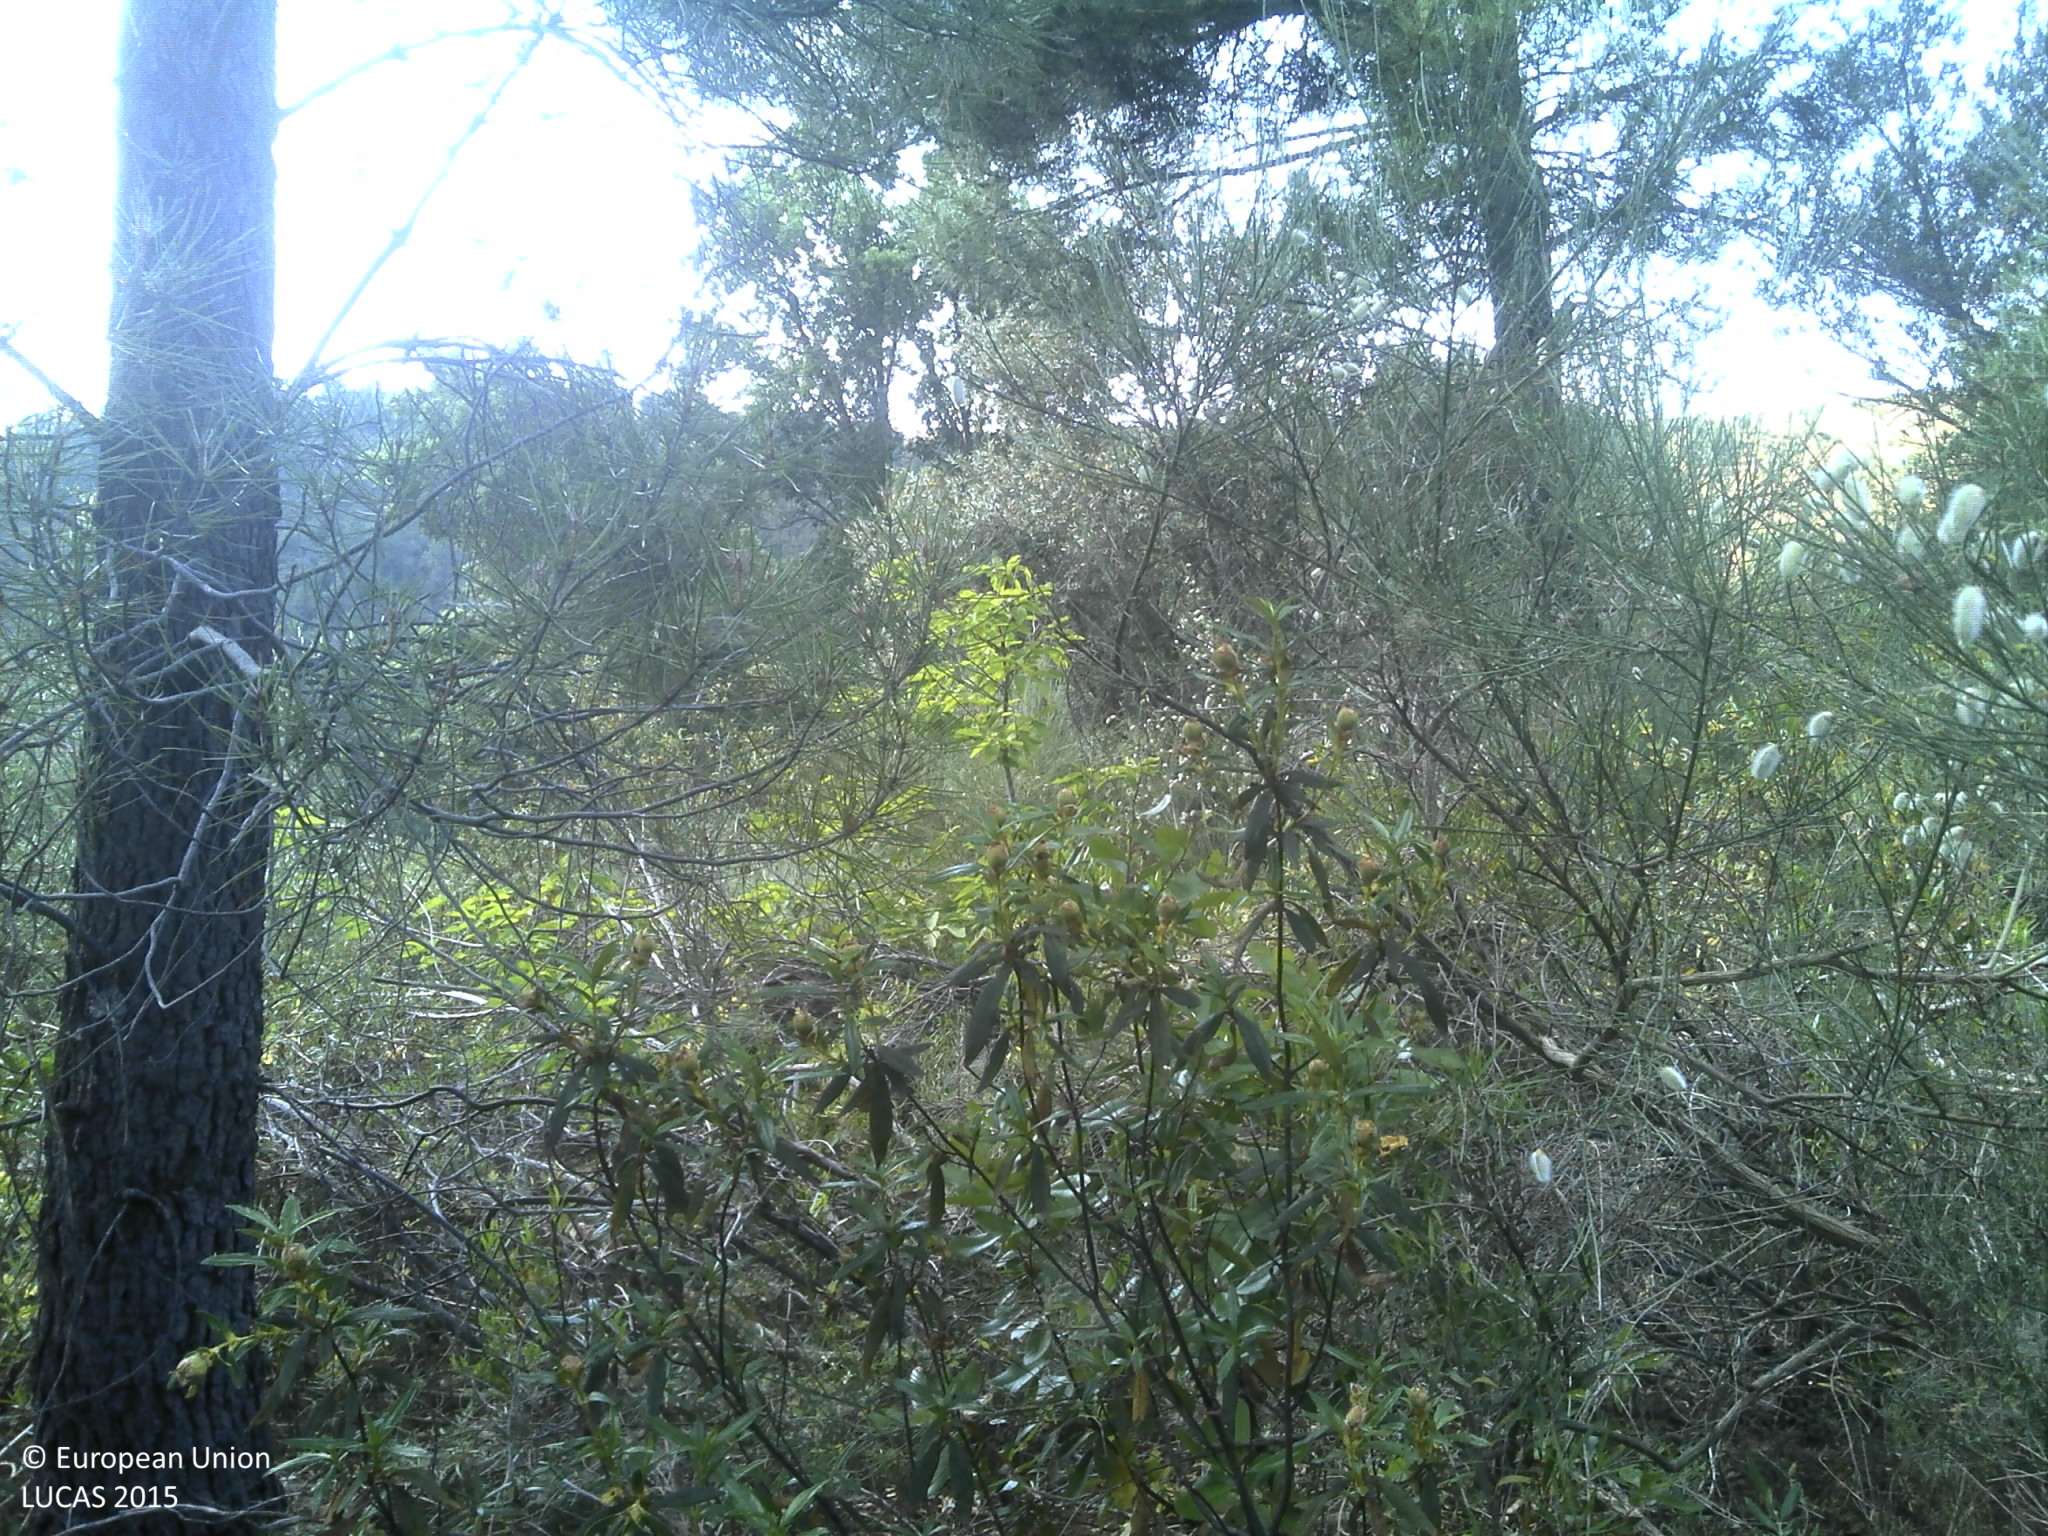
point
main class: Shrubland
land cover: Shrubland with sparse tree cover
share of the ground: 50 - 75 %
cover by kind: shrubs 75 %, unconsolidated bare surface 10 %, coniferous forest trees 5 %
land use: Forestry
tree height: > 5 m
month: June
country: PT
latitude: 40.2770
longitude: -7.1400
